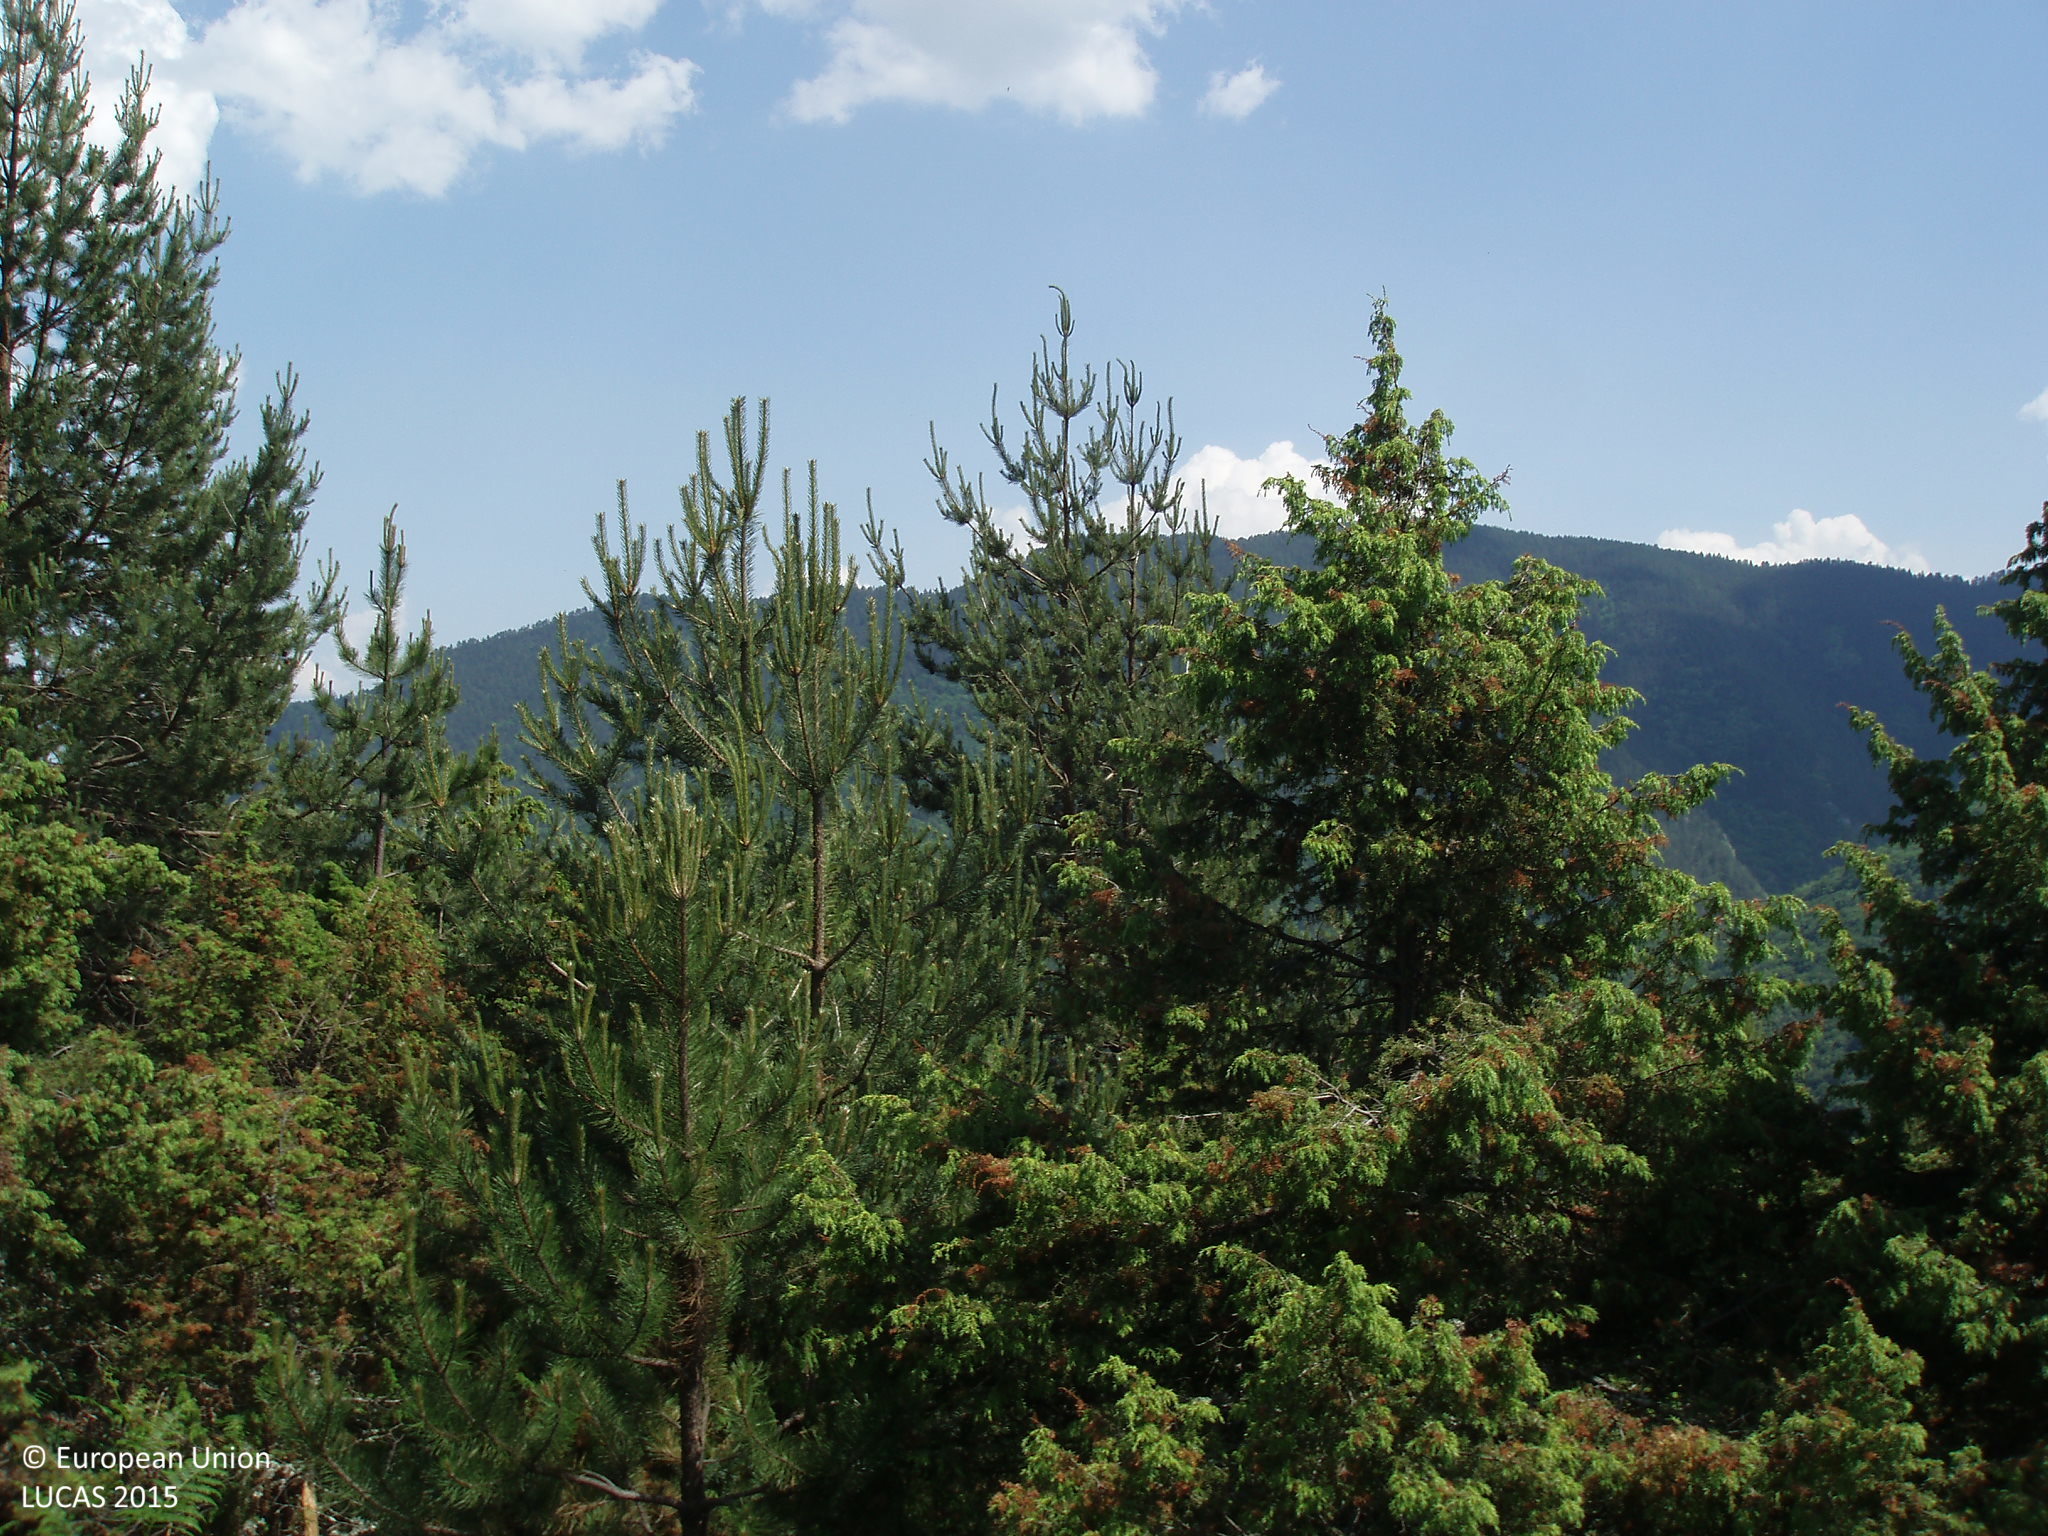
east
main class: Woodland
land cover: Other mixed woodland
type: hemiboreal forest and nemoral coniferous forest and mixed broadleaved-coniferous forest
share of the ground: > 75 %
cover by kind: coniferous forest trees 75 %, broadleaved forest trees 25 %
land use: Forestry
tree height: > 5 m
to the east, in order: Other mixed woodland; Shrubland with sparse tree cover
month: June
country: BG
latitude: 41.4316
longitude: 23.6558
